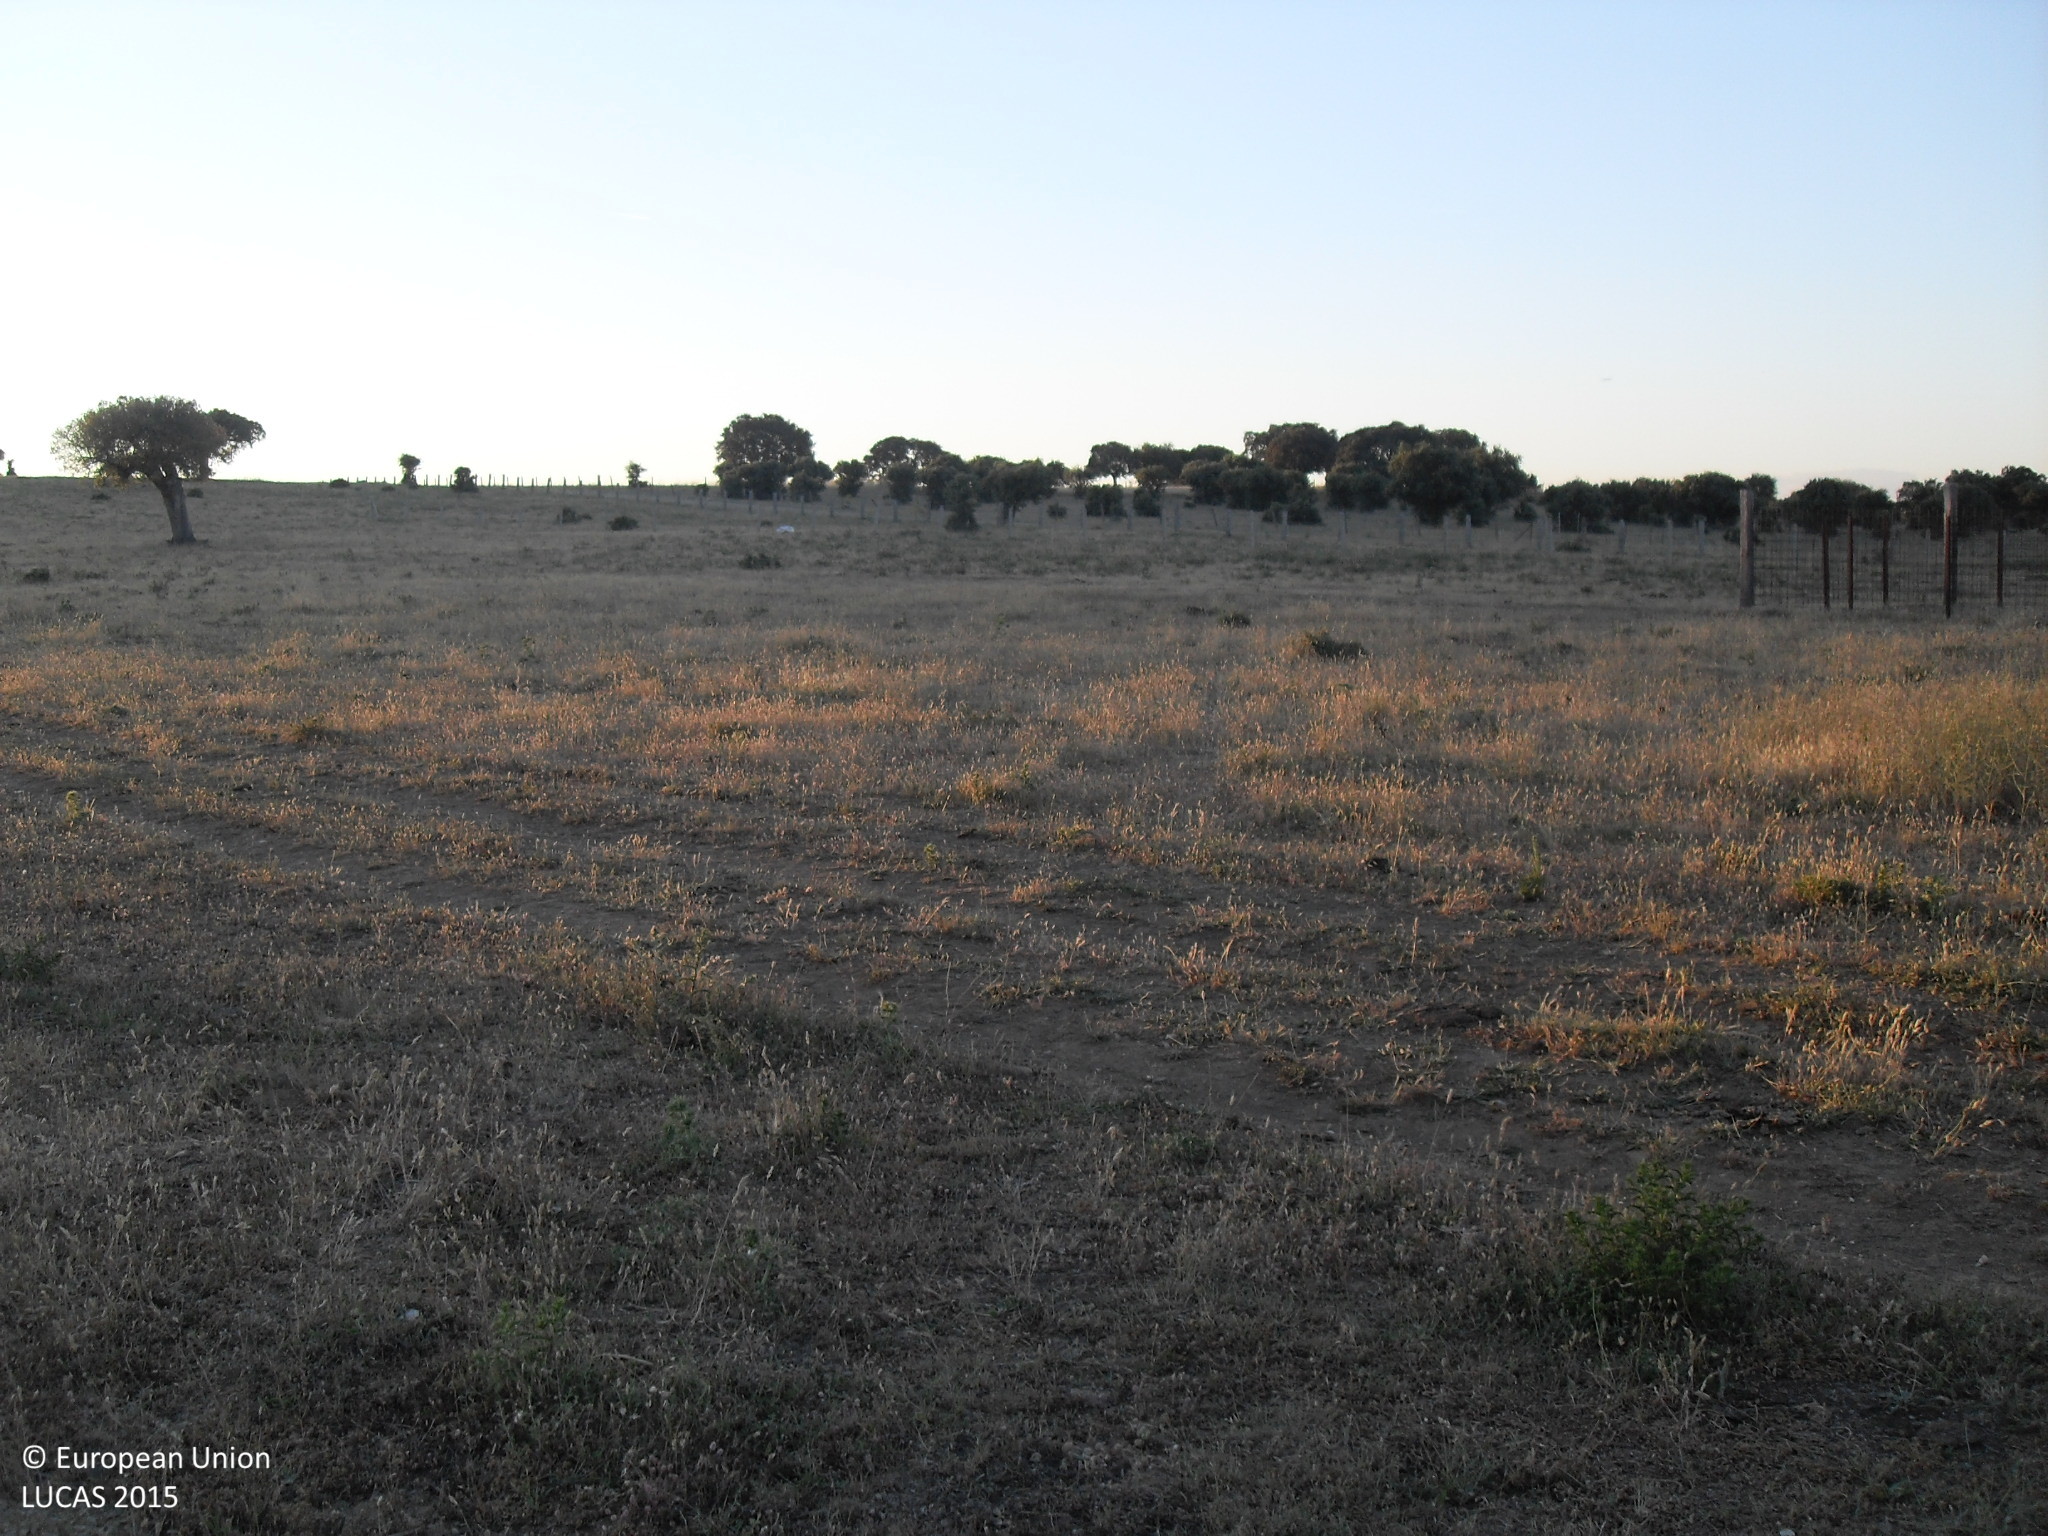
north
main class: Grassland
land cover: Grassland without tree/shrub cover
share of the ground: > 75 %
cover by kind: herbaceous plants 100 %
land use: Agriculture (excluding fallow land and kitchen gardens)
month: June
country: ES
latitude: 40.5867
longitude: -5.6314
